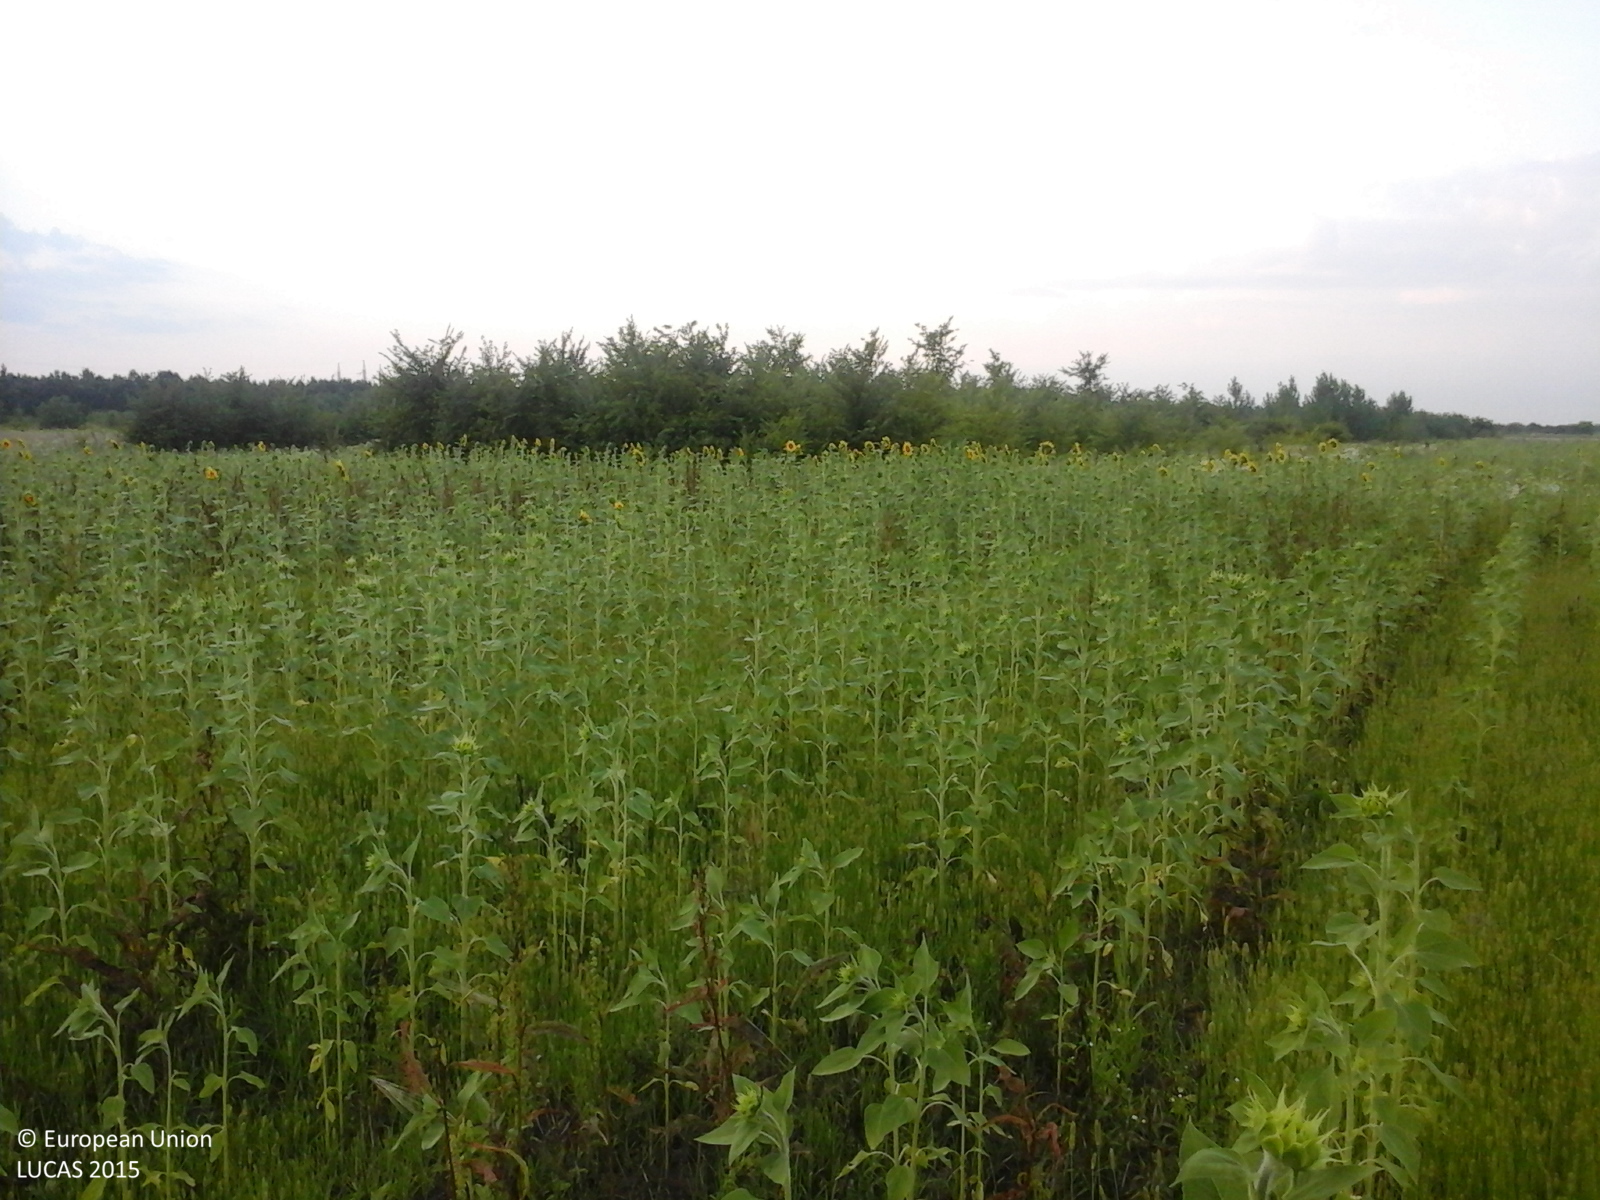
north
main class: Cropland
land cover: Sunflower
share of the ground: 50 - 75 %
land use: Agriculture (excluding fallow land and kitchen gardens)
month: July
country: RO
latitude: 43.9597
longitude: 25.2987
